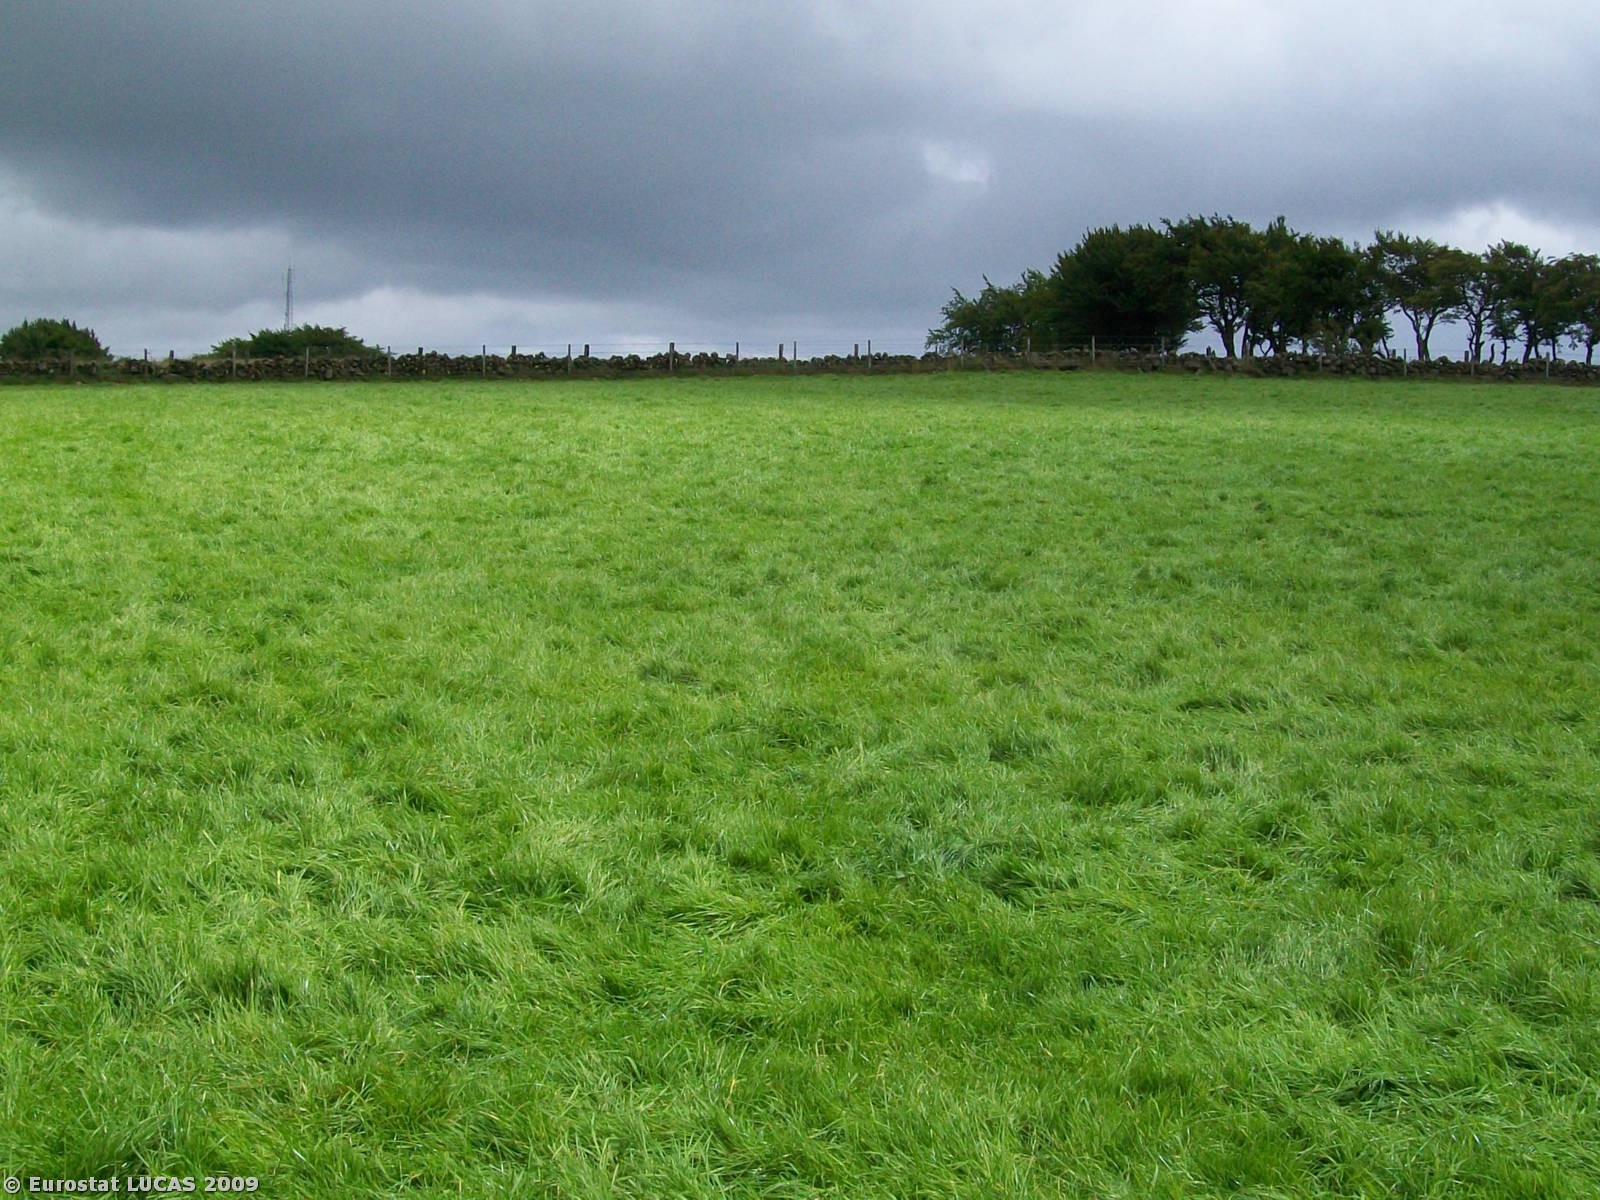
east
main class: Grassland
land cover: Grassland without tree/shrub cover
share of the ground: > 75 %
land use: Agriculture (excluding fallow land and kitchen gardens)
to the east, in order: Grassland without tree/shrub cover; Fences; Dry stone walls; Fences; Grassland without tree/shrub cover; Broadleaved woodland; Dry stone walls; Grassland without tree/shrub cover; Fences; Dry stone walls; Grass margins; Paved roads, cycling and walking lanes; Grass margins; Dry stone walls; Fences; Grassland without tree/shrub cover; Dry stone walls; Grassland without tree/shrub cover
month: July
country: GB
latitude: 54.7707
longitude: -5.8514
